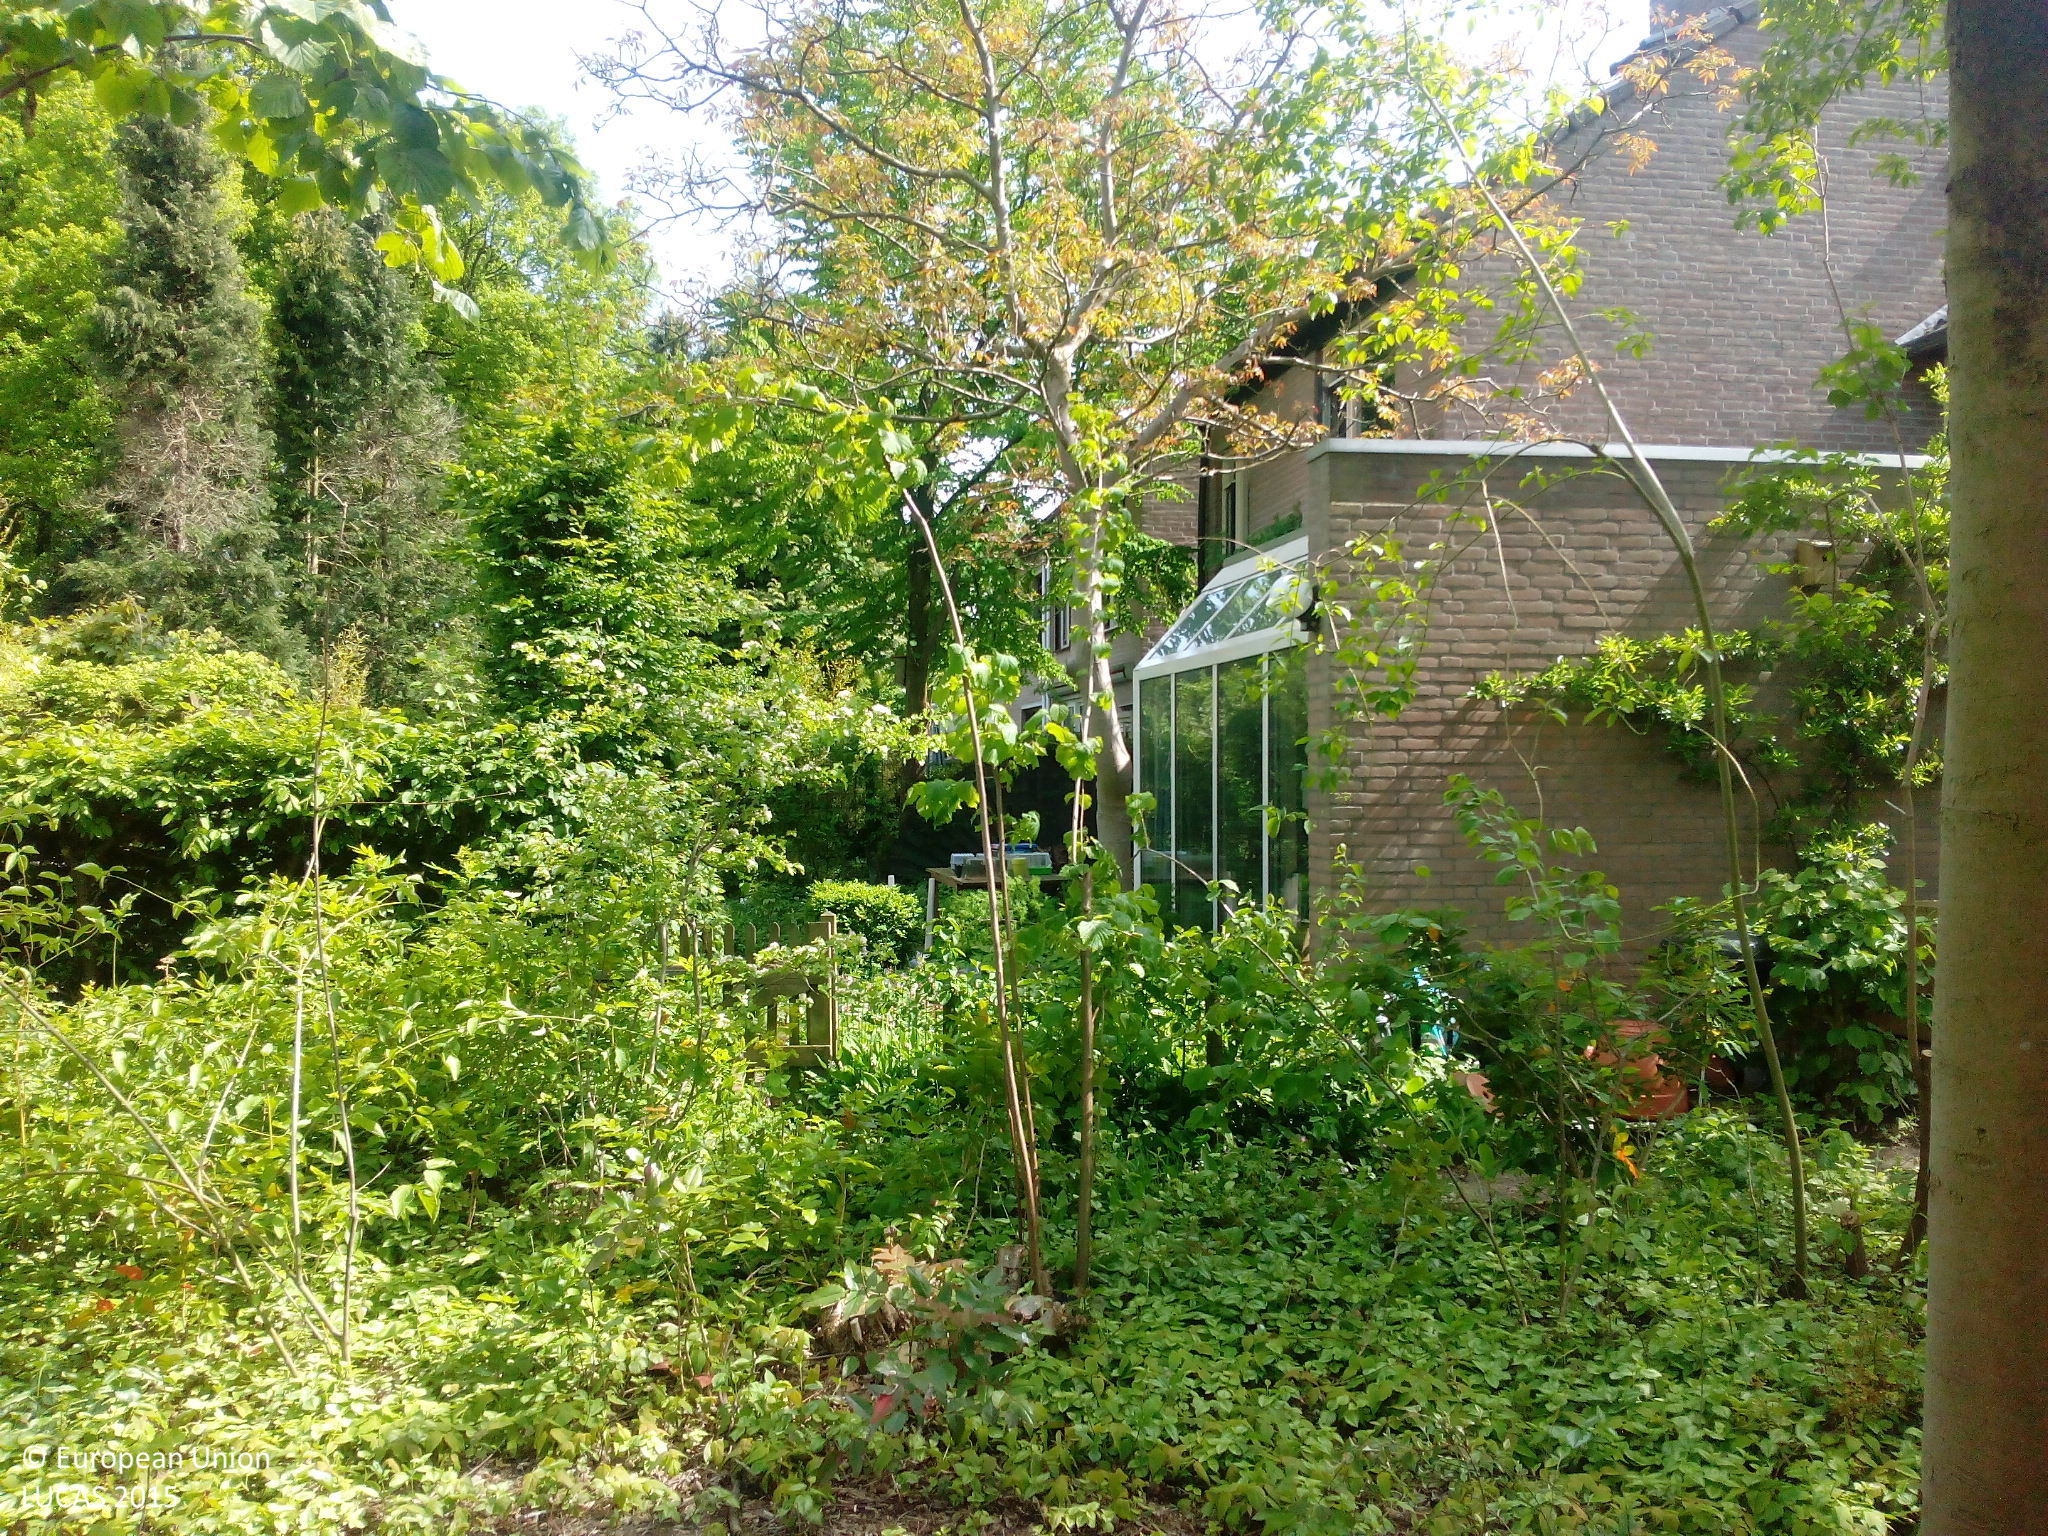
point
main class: Woodland
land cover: Broadleaved woodland
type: mesophytic deciduous forest
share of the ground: 50 - 75 %
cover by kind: broadleaved forest trees 50 %, consolidated bare surface 50 %
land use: Residential
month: May
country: NL
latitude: 51.5187
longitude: 5.5163
